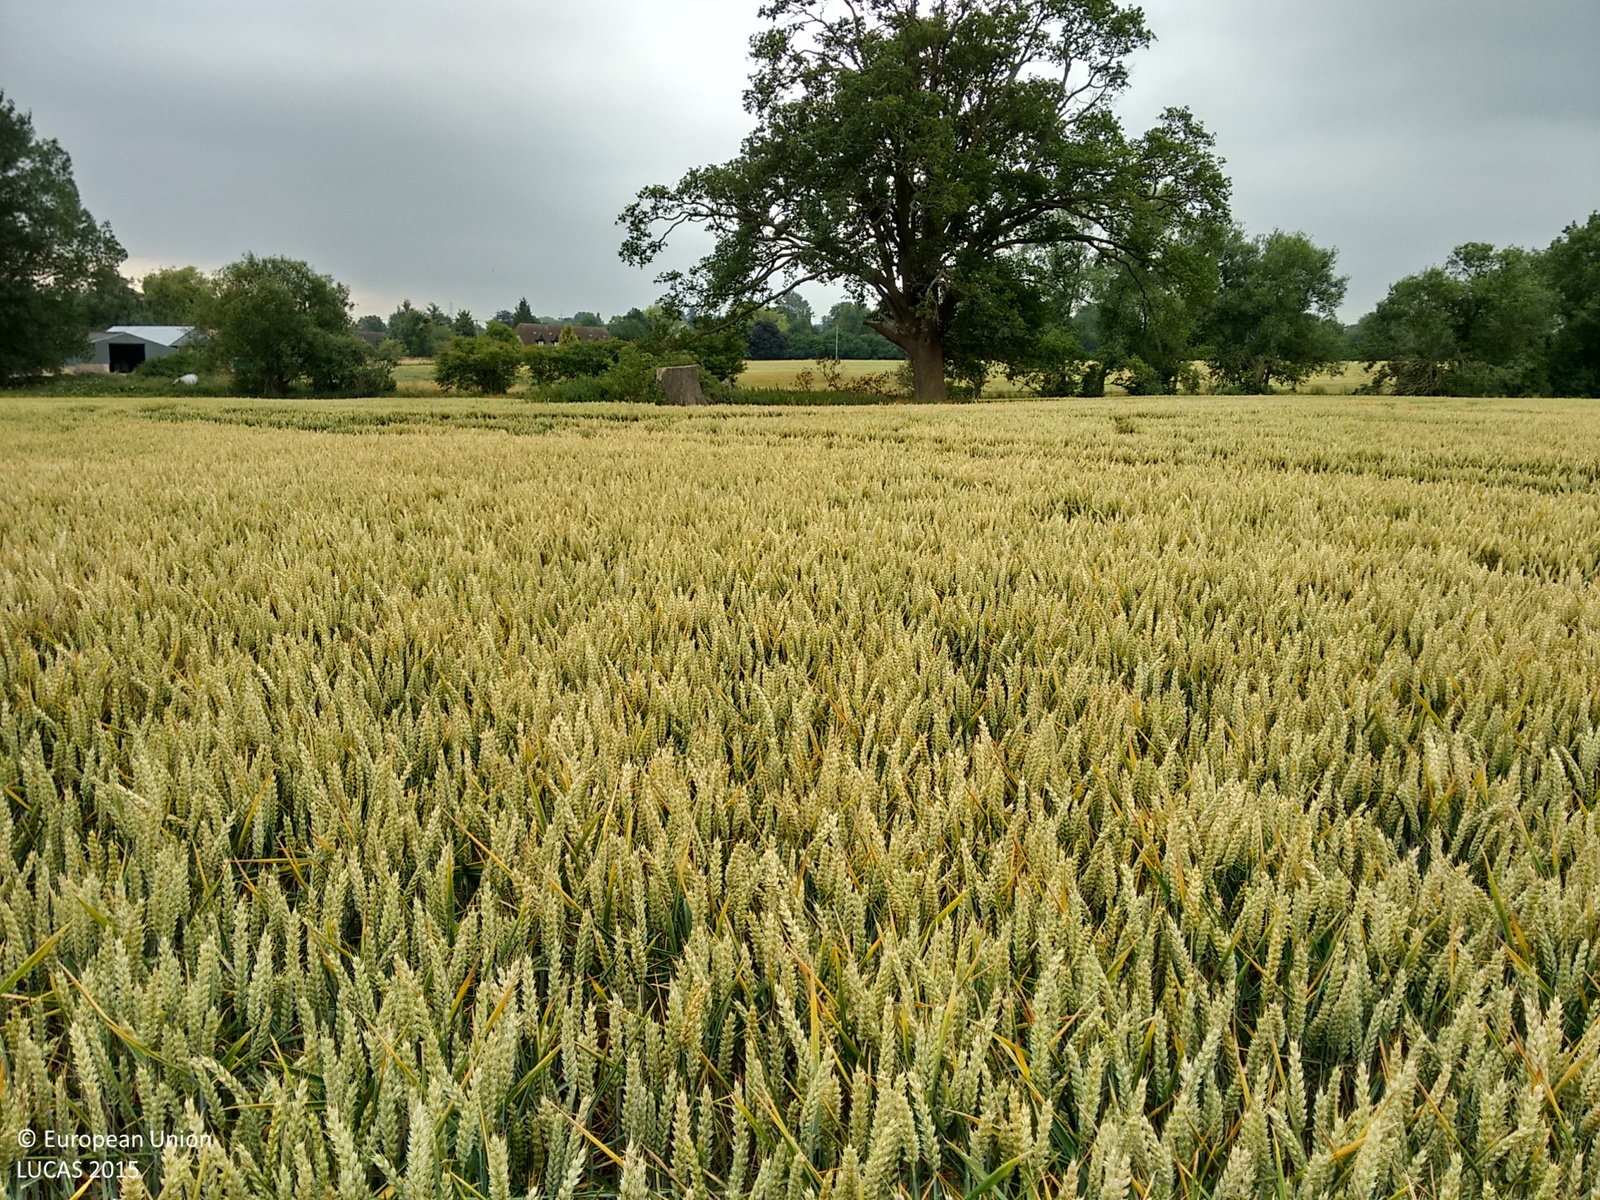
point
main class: Cropland
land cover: Common wheat
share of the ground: > 75 %
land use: Agriculture (excluding fallow land and kitchen gardens)
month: July
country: GB
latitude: 51.7615
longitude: -1.1301
